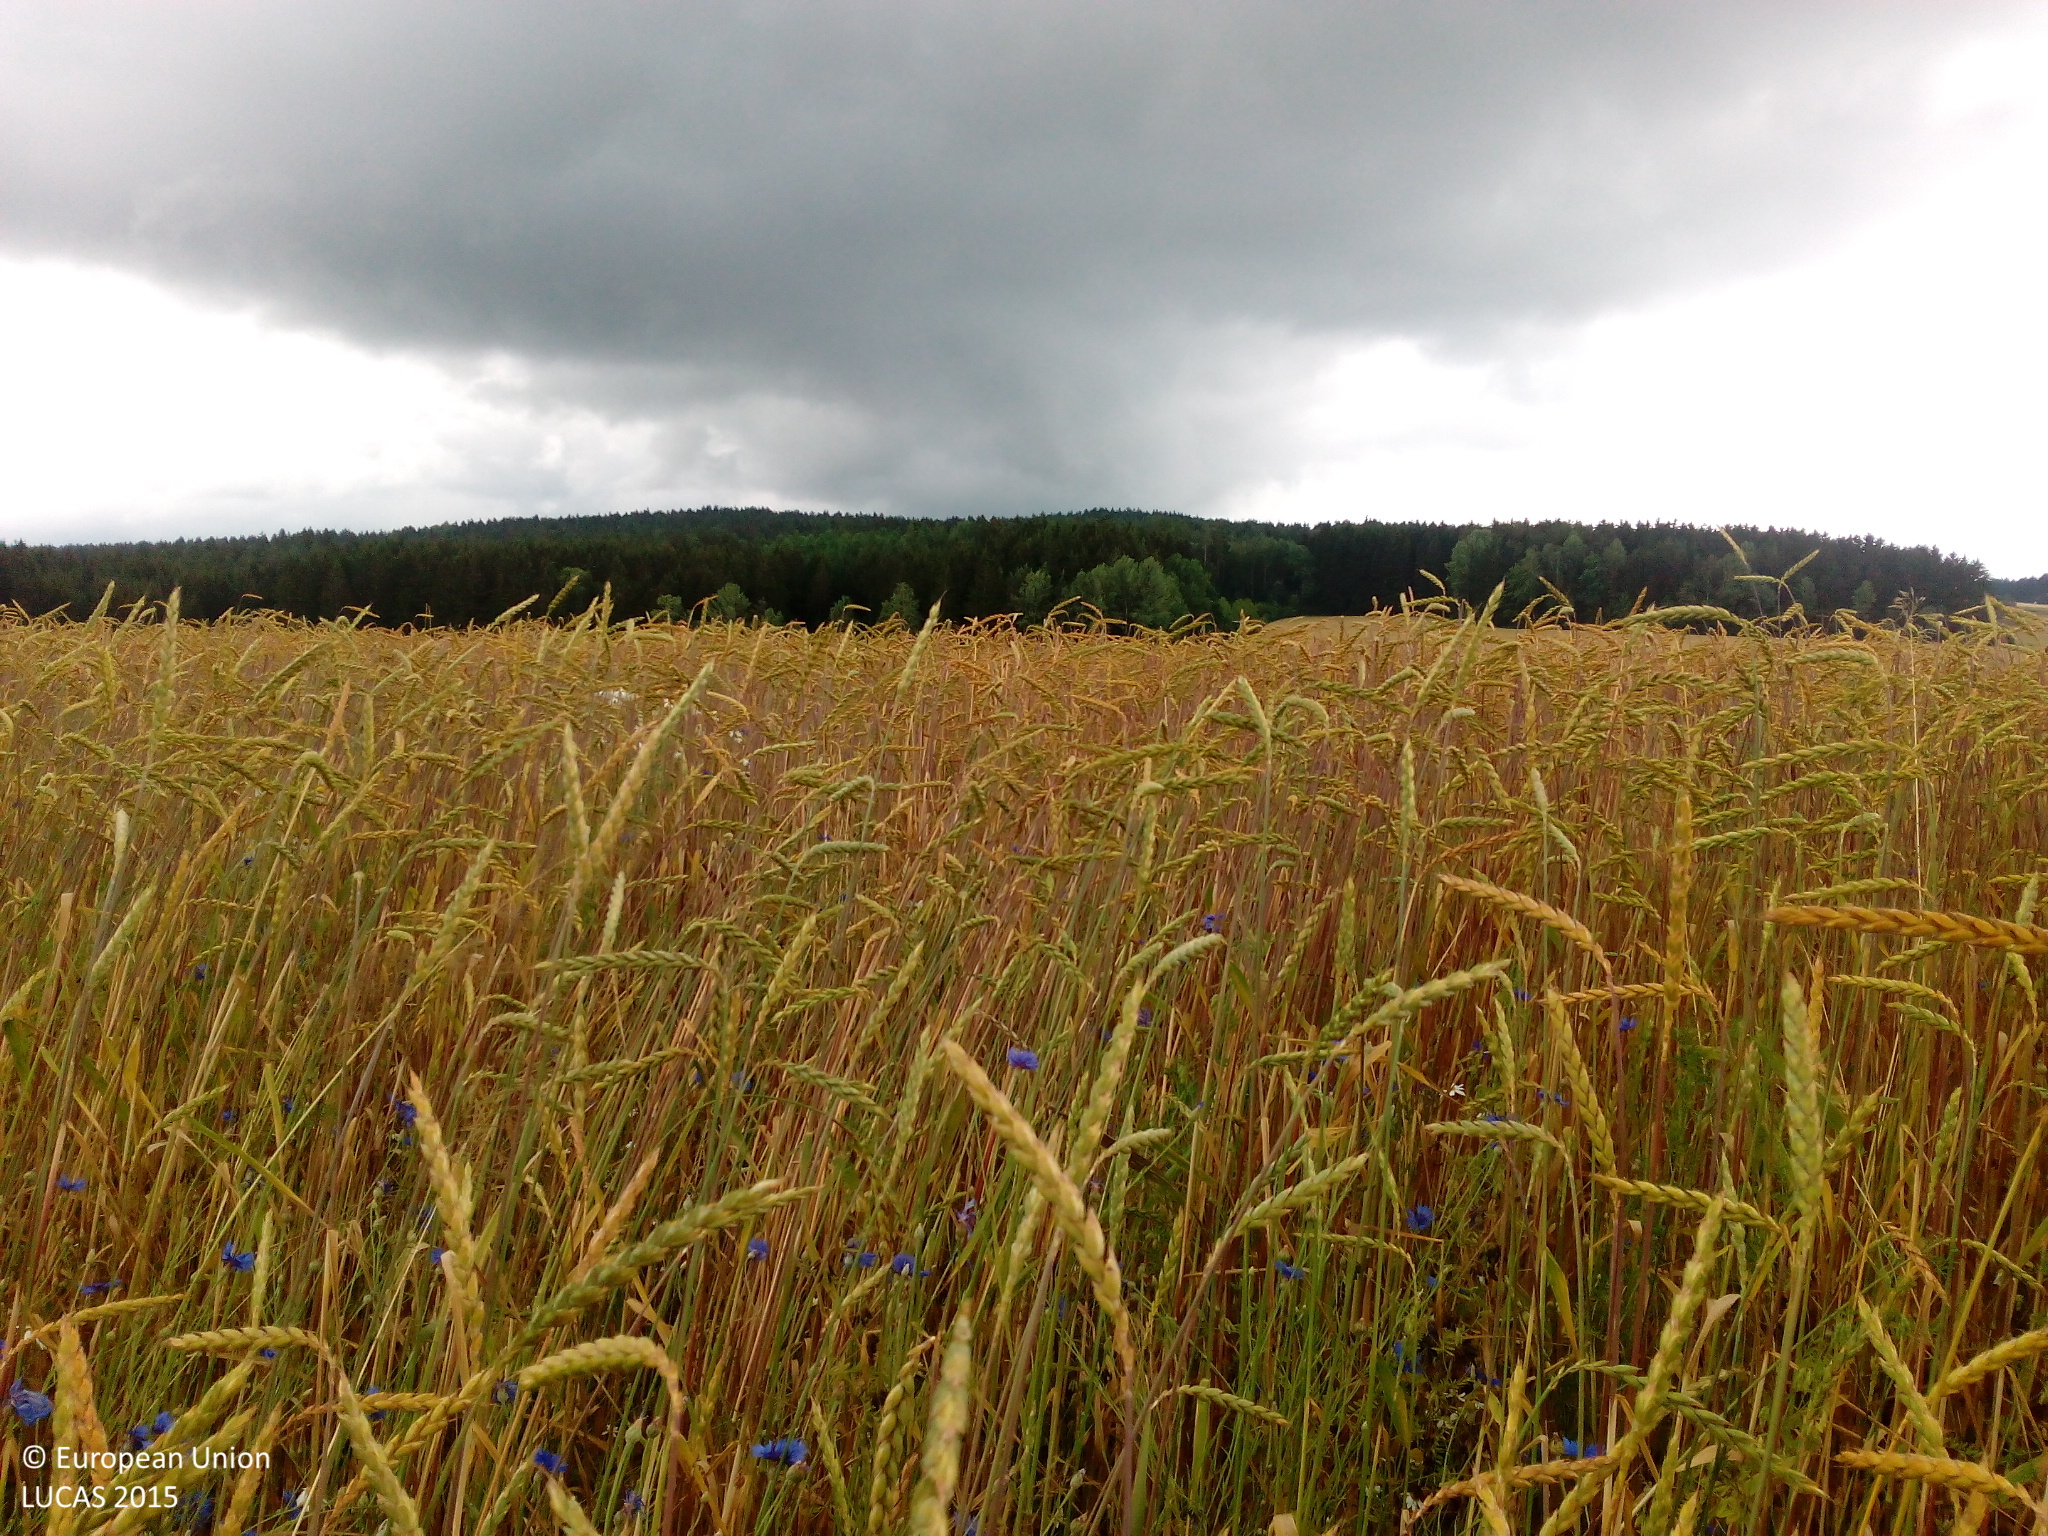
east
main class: Cropland
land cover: Common wheat
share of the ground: > 75 %
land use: Agriculture (excluding fallow land and kitchen gardens)
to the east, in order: Common wheat; Grass margins; Common wheat
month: July
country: DE
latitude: 49.4750
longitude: 12.4147
